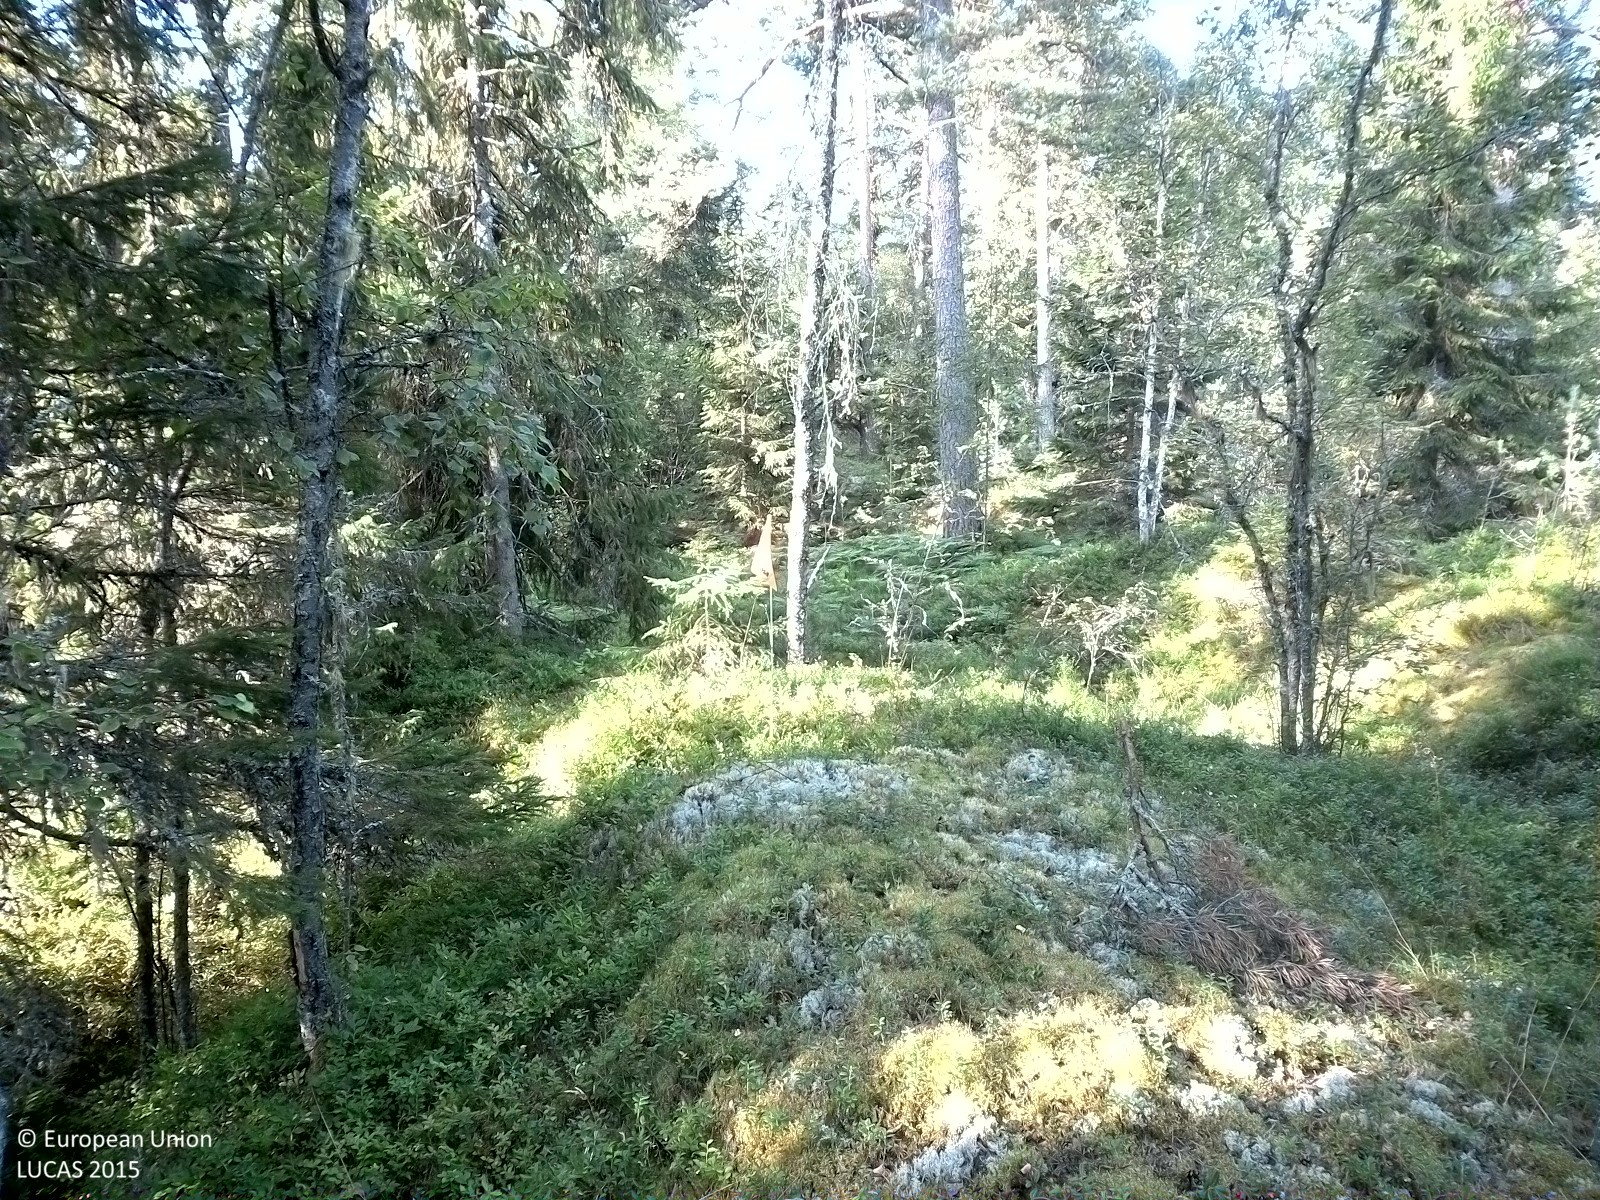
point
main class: Woodland
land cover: Other mixed woodland
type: hemiboreal forest and nemoral coniferous forest and mixed broadleaved-coniferous forest
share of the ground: 25 - 50 %
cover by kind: herbaceous plants 35 %, coniferous forest trees 30 %, lichens and mosses 20 %, broadleaved forest trees 15 %
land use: Forestry
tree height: > 5 m
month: August
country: SE
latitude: 58.8142
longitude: 14.9274
